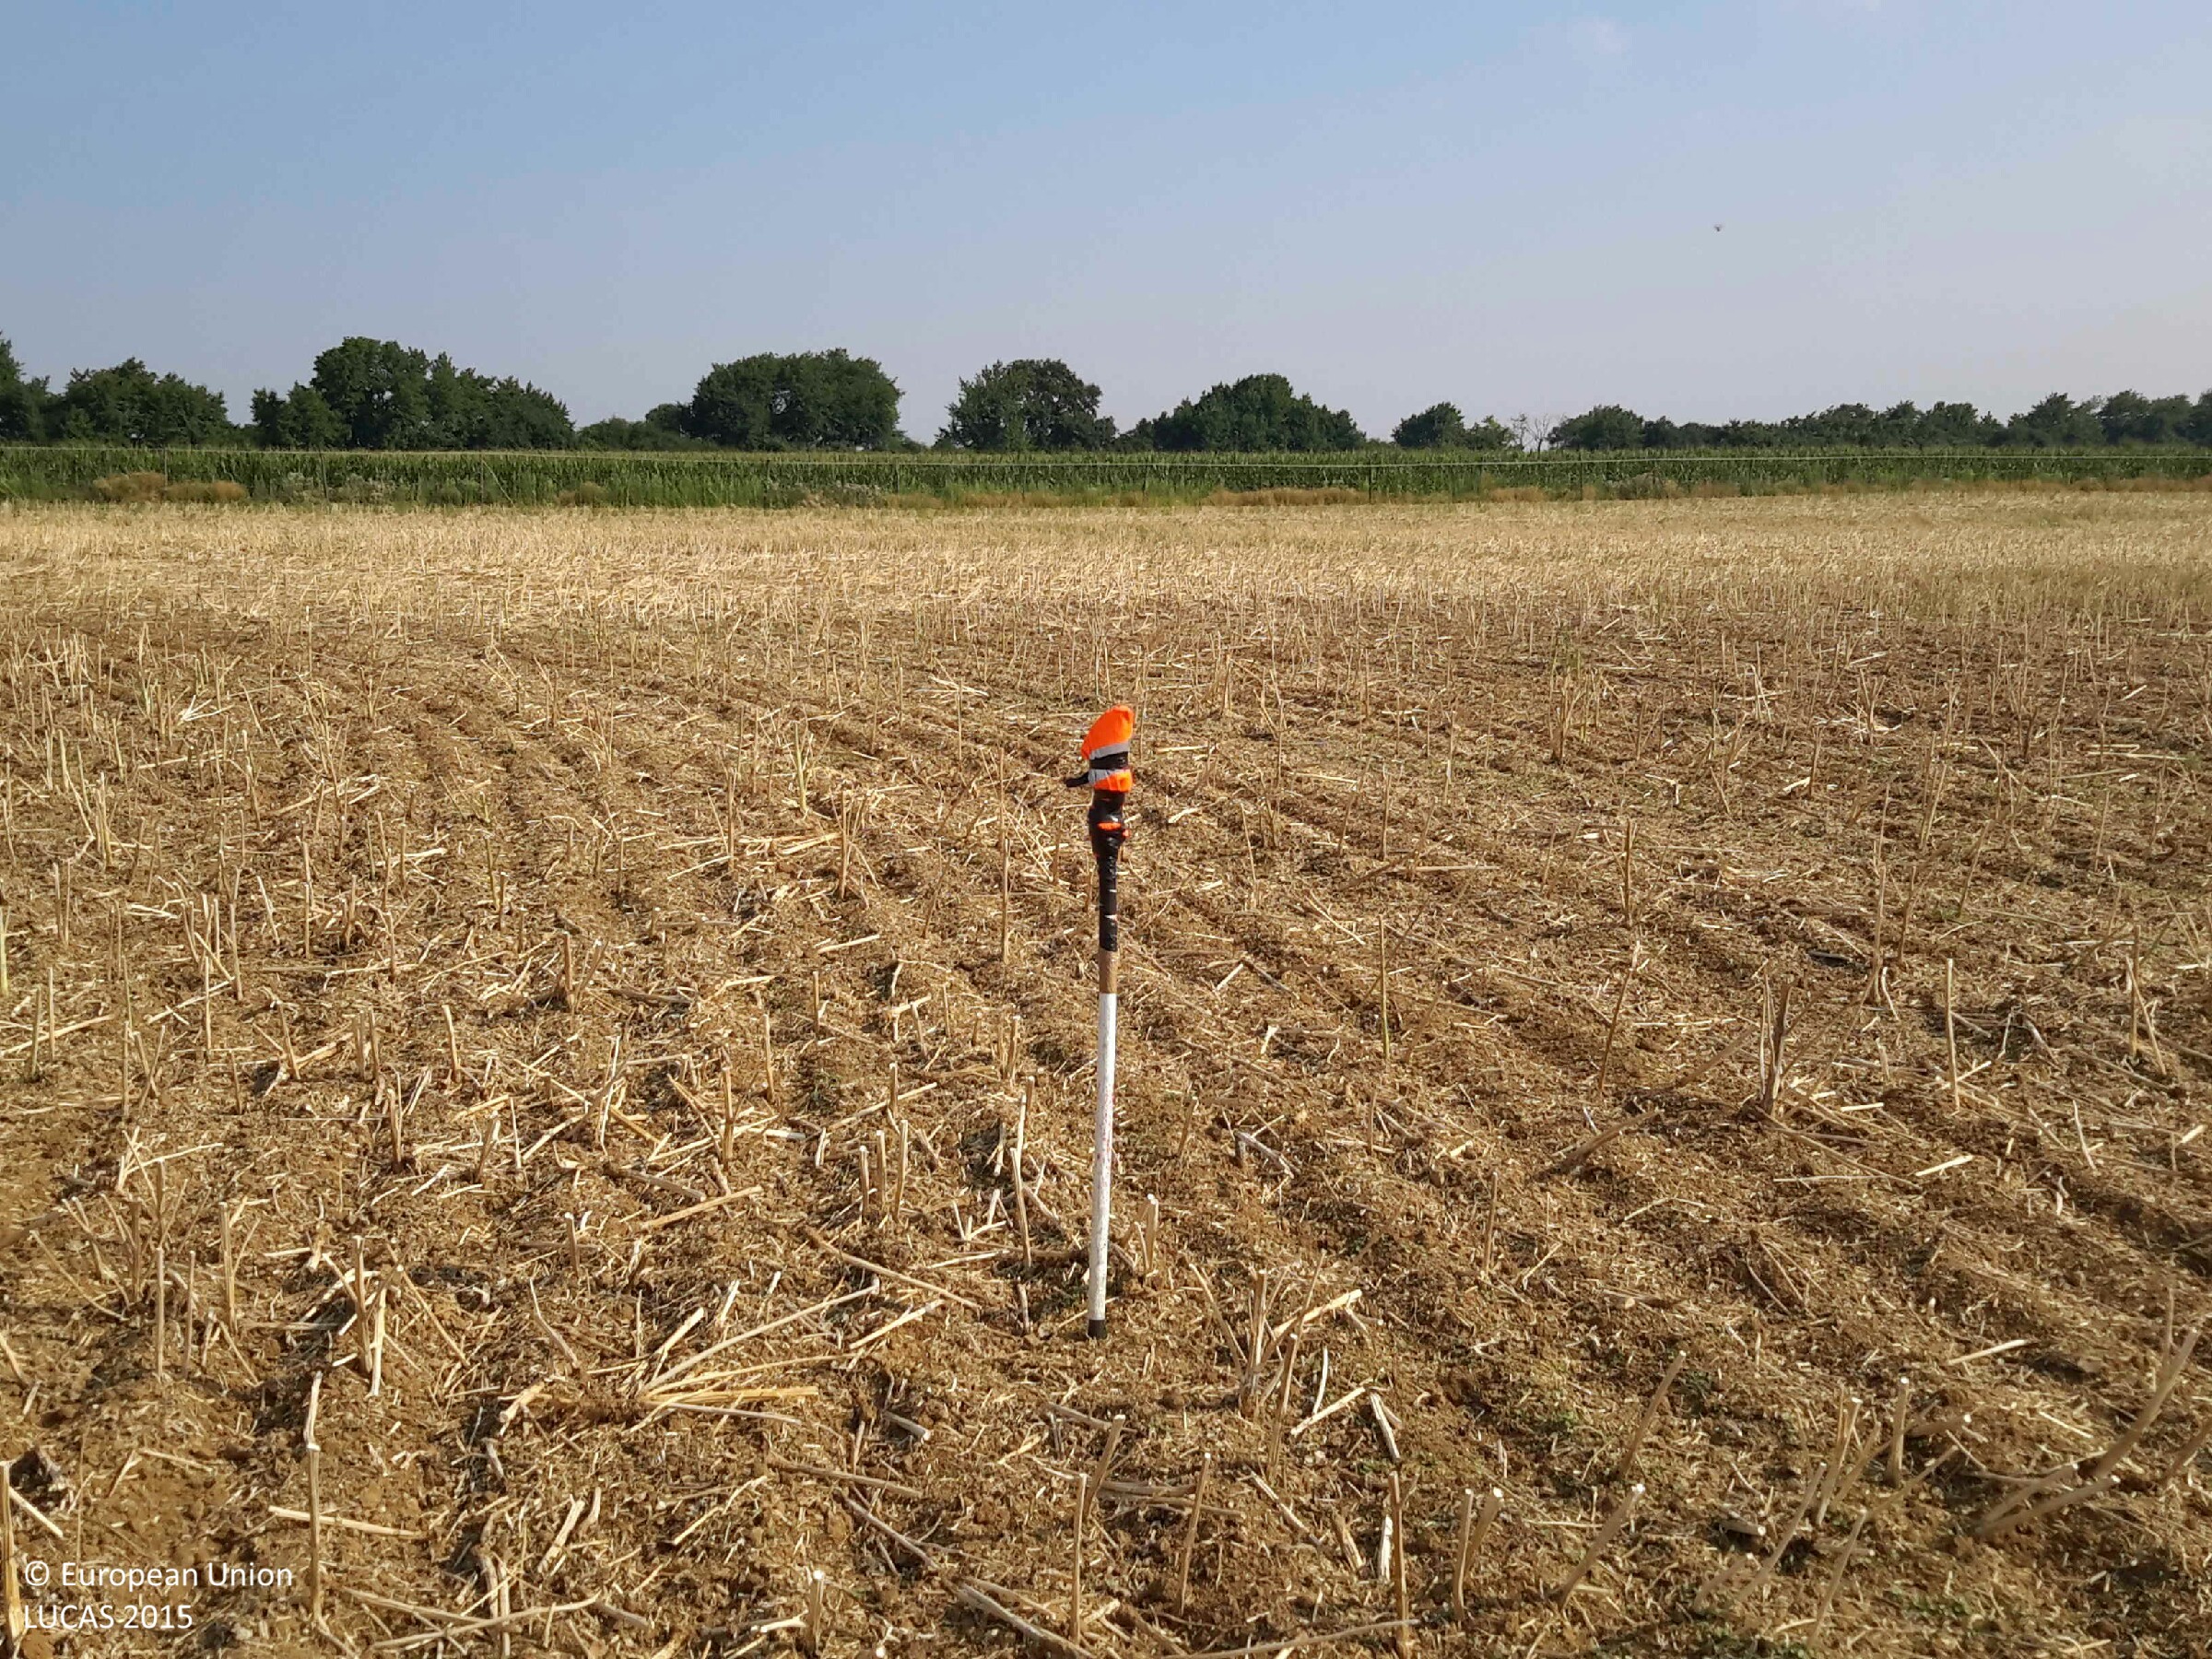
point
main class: Cropland
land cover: Rape and turnip rape
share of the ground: 10 - 25 %
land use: Agriculture (excluding fallow land and kitchen gardens)
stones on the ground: < 10 %
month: July
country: HU
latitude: 47.4450
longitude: 16.6482
